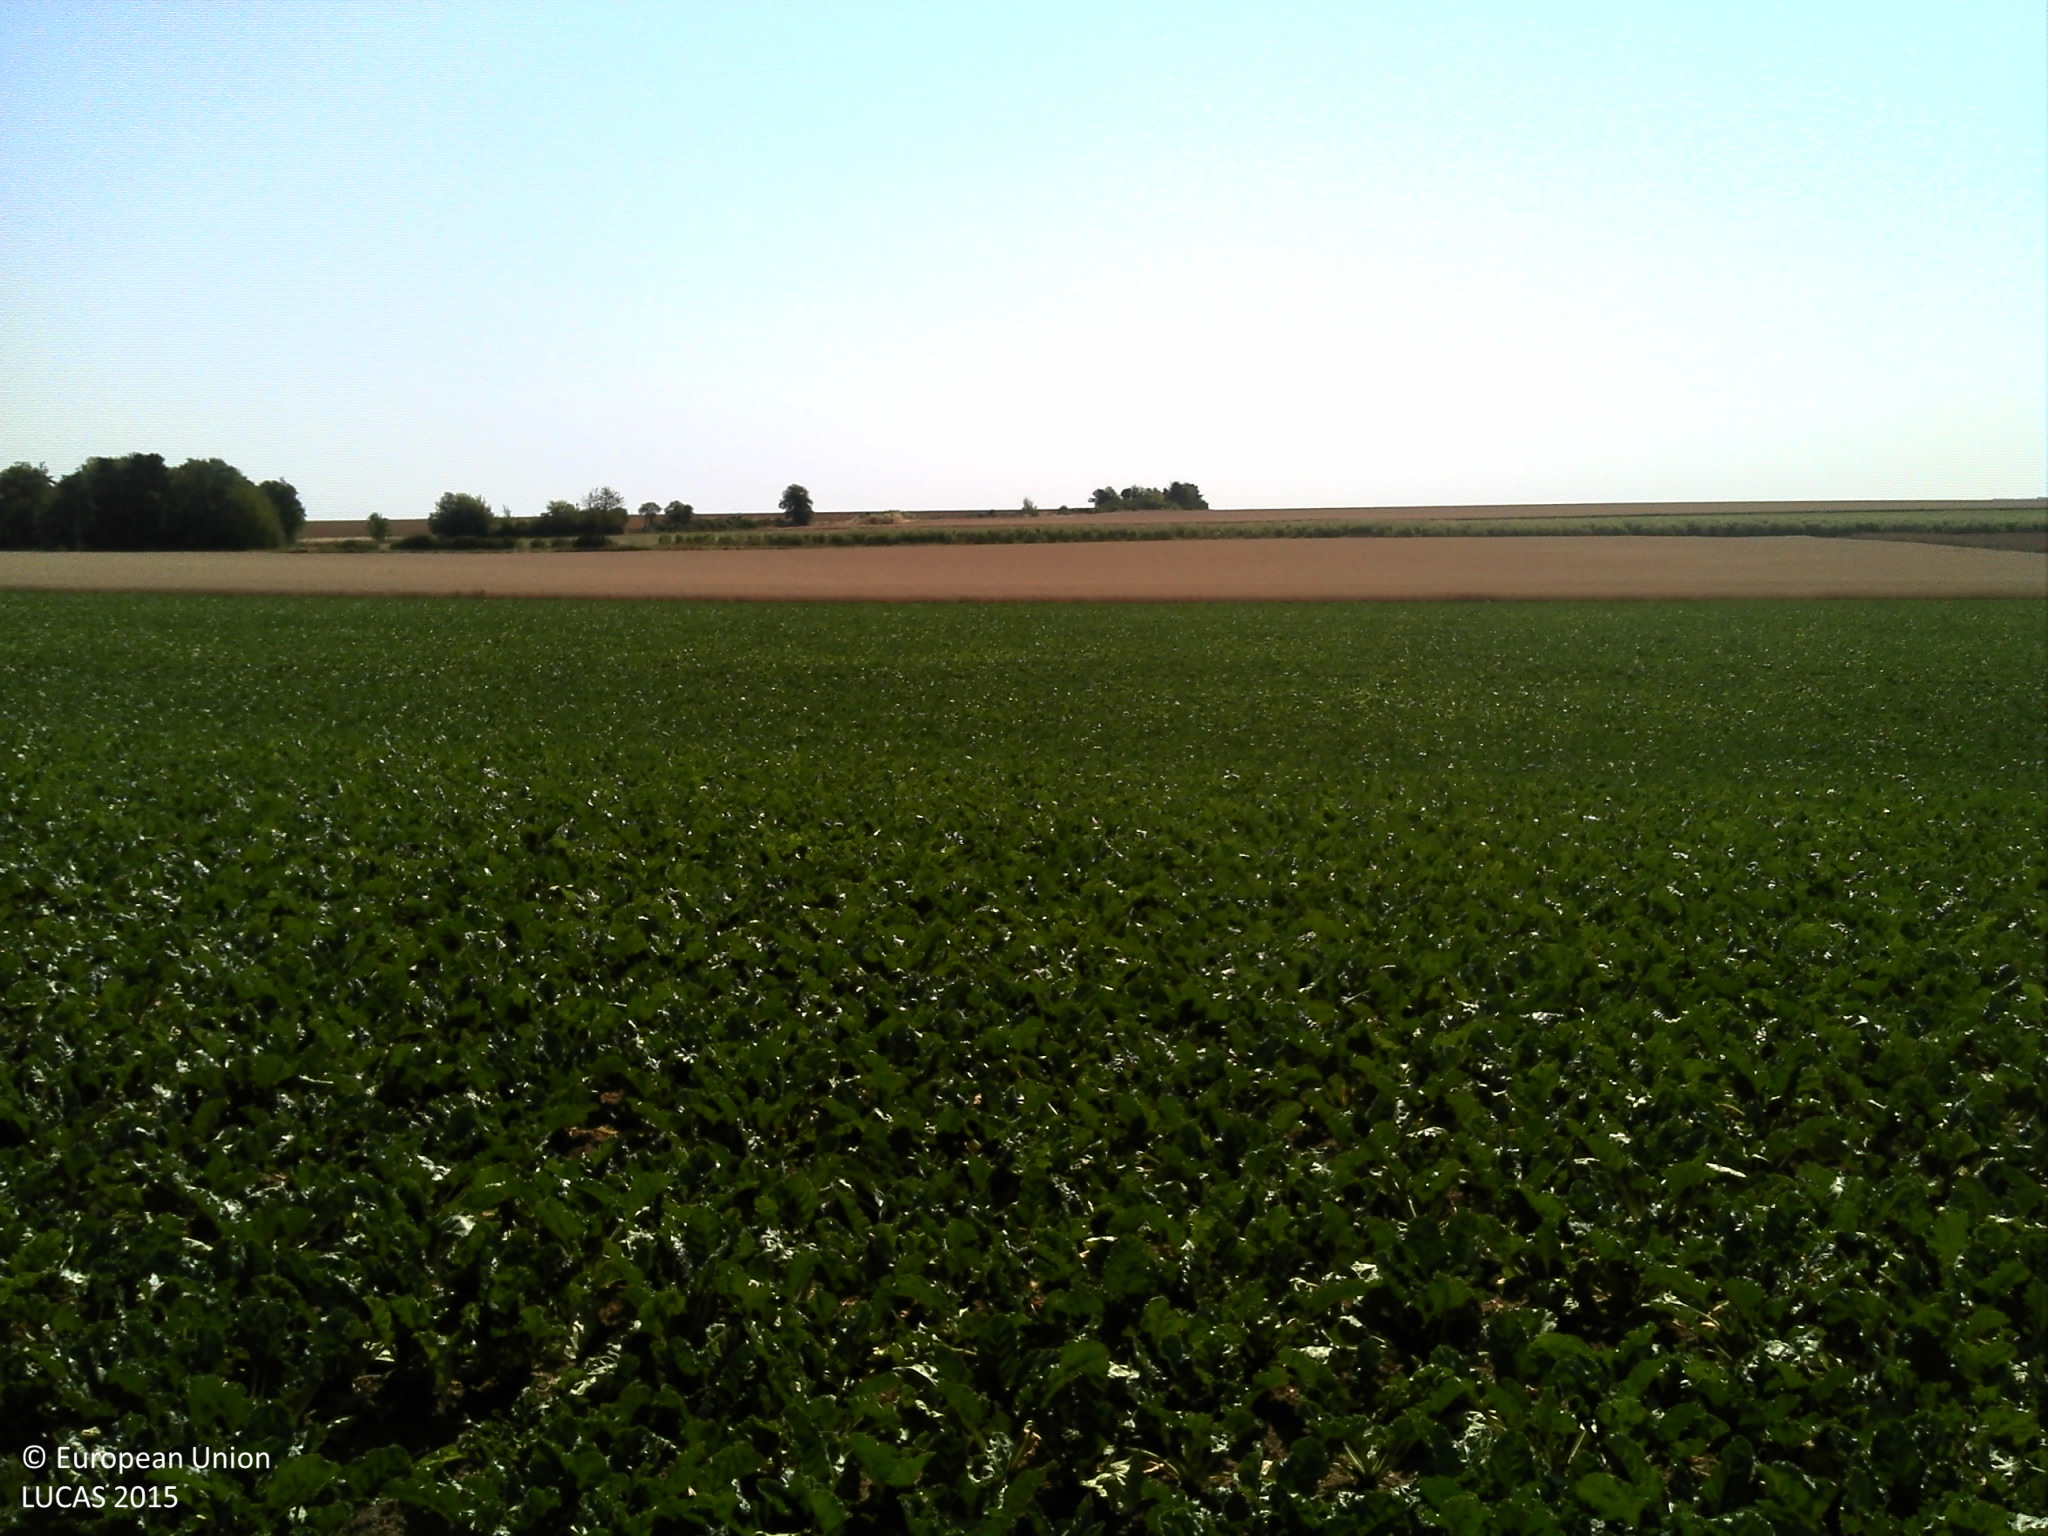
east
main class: Cropland
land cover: Sugar beet
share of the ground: > 75 %
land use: Agriculture (excluding fallow land and kitchen gardens)
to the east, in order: Sugar beet; Common wheat
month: July
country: FR
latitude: 49.4368
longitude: 4.1067
